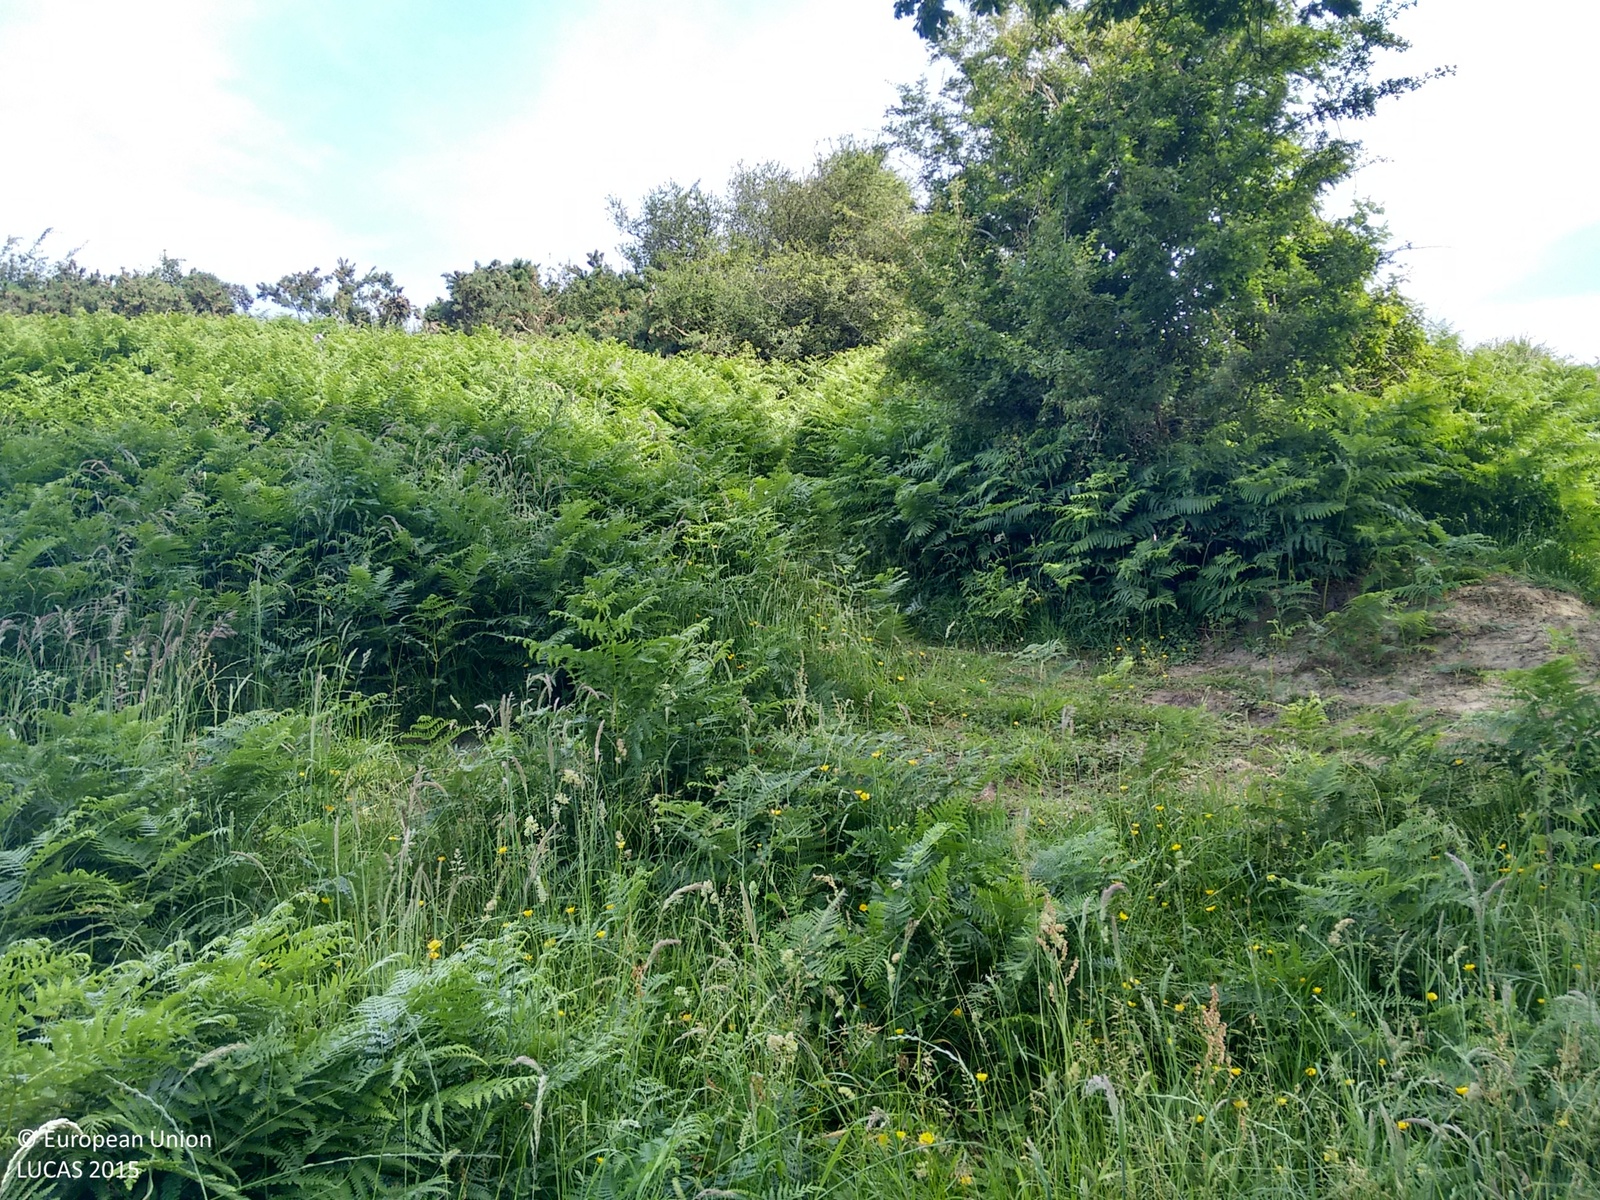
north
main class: Grassland
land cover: Grassland with sparse tree/shrub cover
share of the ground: > 75 %
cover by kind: herbaceous plants 85 %, shrubs 10 %, broadleaved forest trees 5 %
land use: Agriculture (excluding fallow land and kitchen gardens)
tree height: > 5 m
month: June
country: GB
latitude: 50.8633
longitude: 0.3808
